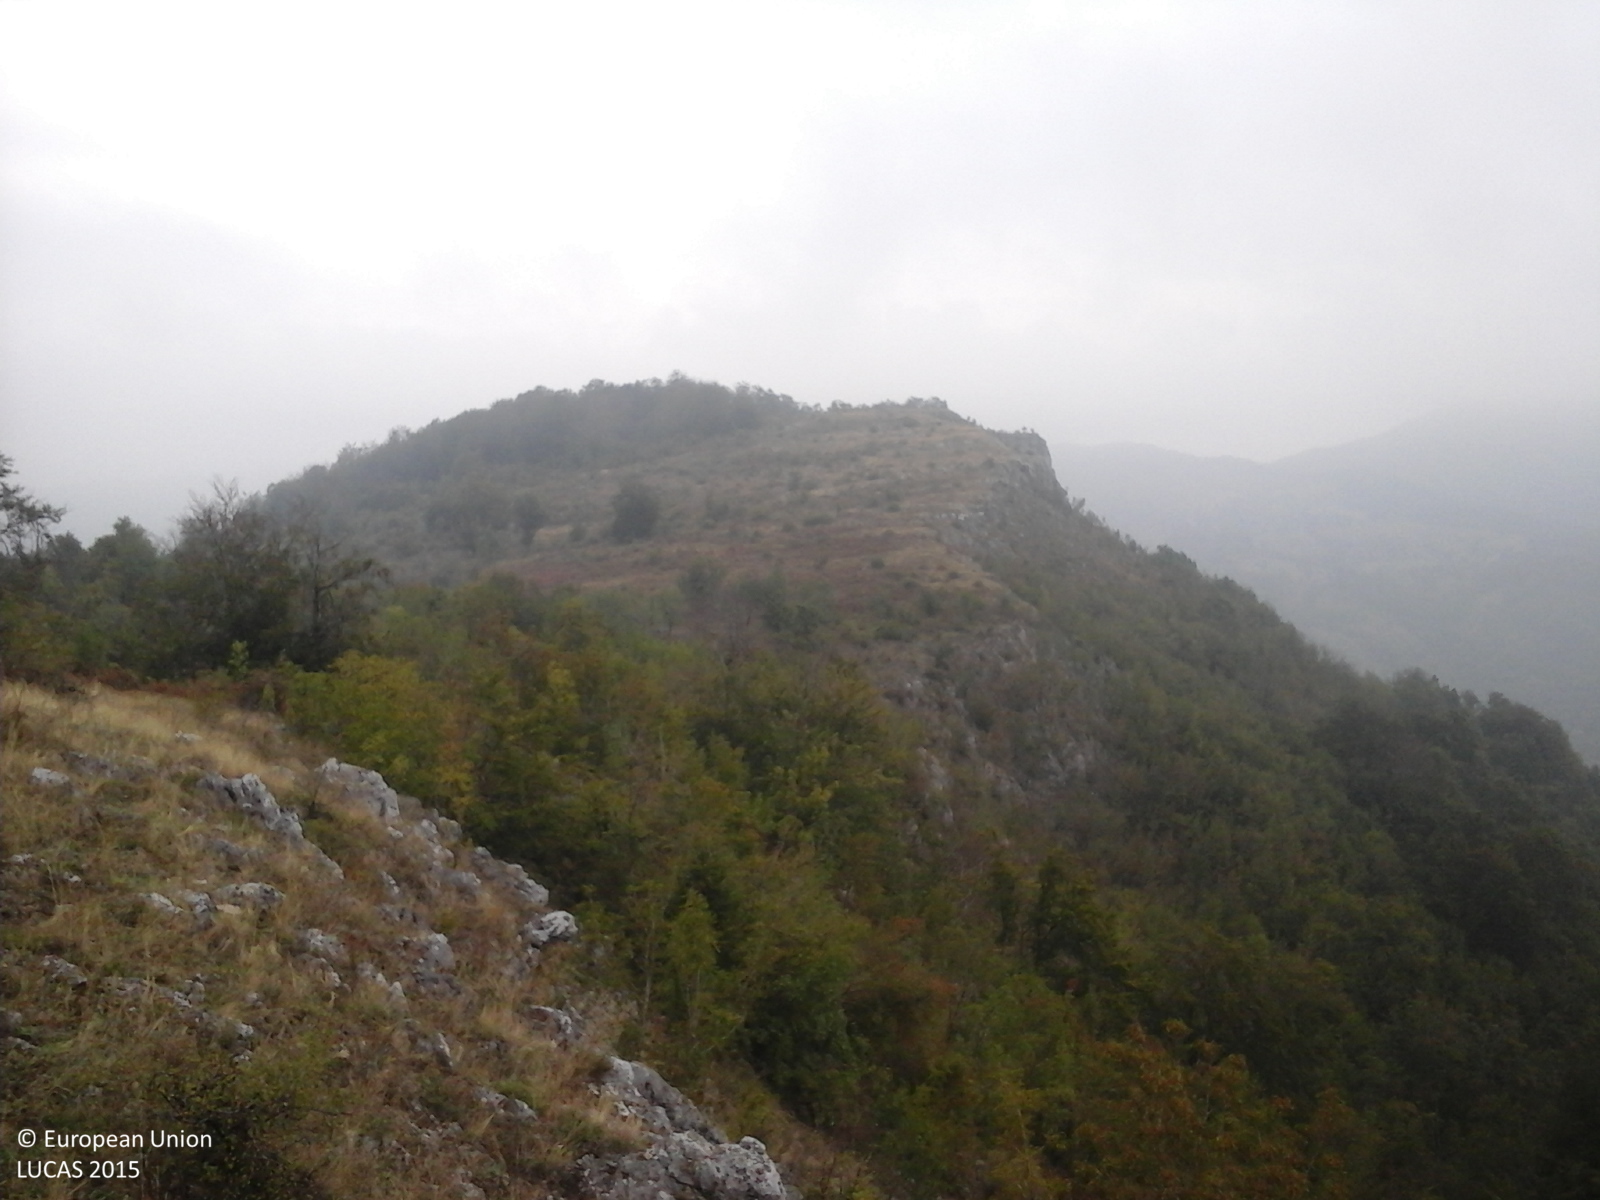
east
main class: Shrubland
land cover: Shrubland without tree cover
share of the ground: > 75 %
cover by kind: shrubs 90 %, herbaceous plants 10 %
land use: Semi-natural and natural areas not in use
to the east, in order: Shrubland without tree cover; Grassland with sparse tree/shrub cover; Broadleaved woodland; Grassland with sparse tree/shrub cover
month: September
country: RO
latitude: 45.0782
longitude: 22.8653
